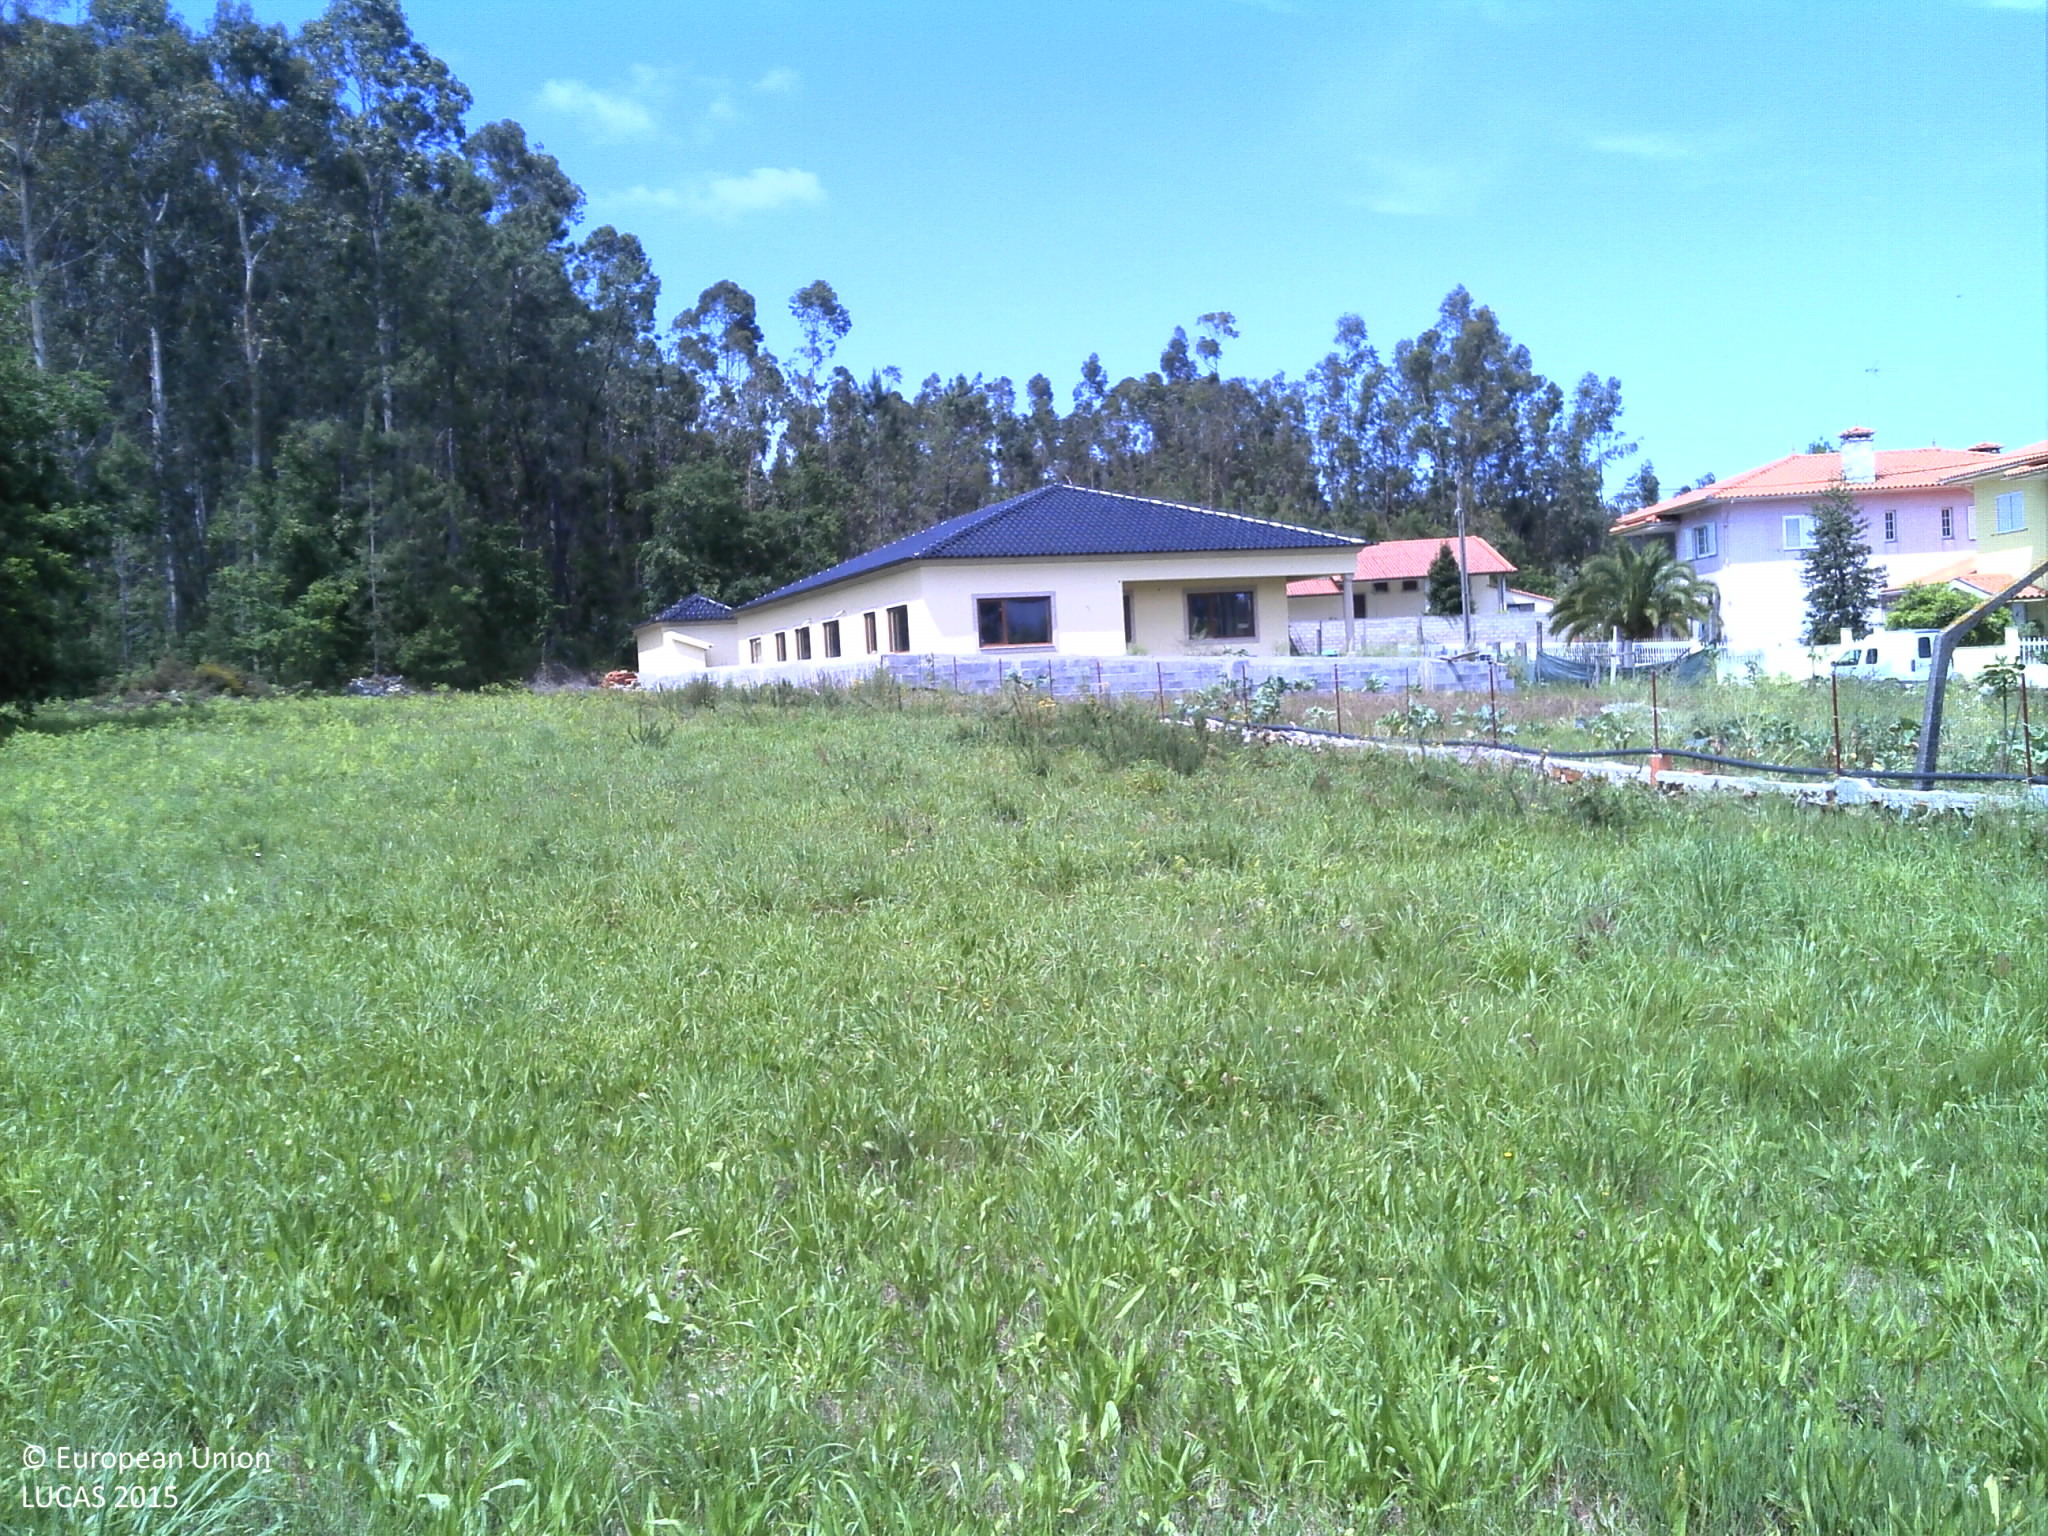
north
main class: Grassland
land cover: Spontaneously vegetated surfaces
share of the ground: > 75 %
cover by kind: herbaceous plants 90 %, unconsolidated bare surface 10 %
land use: Agriculture (excluding fallow land and kitchen gardens)
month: May
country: PT
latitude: 40.8982
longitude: -8.3862
